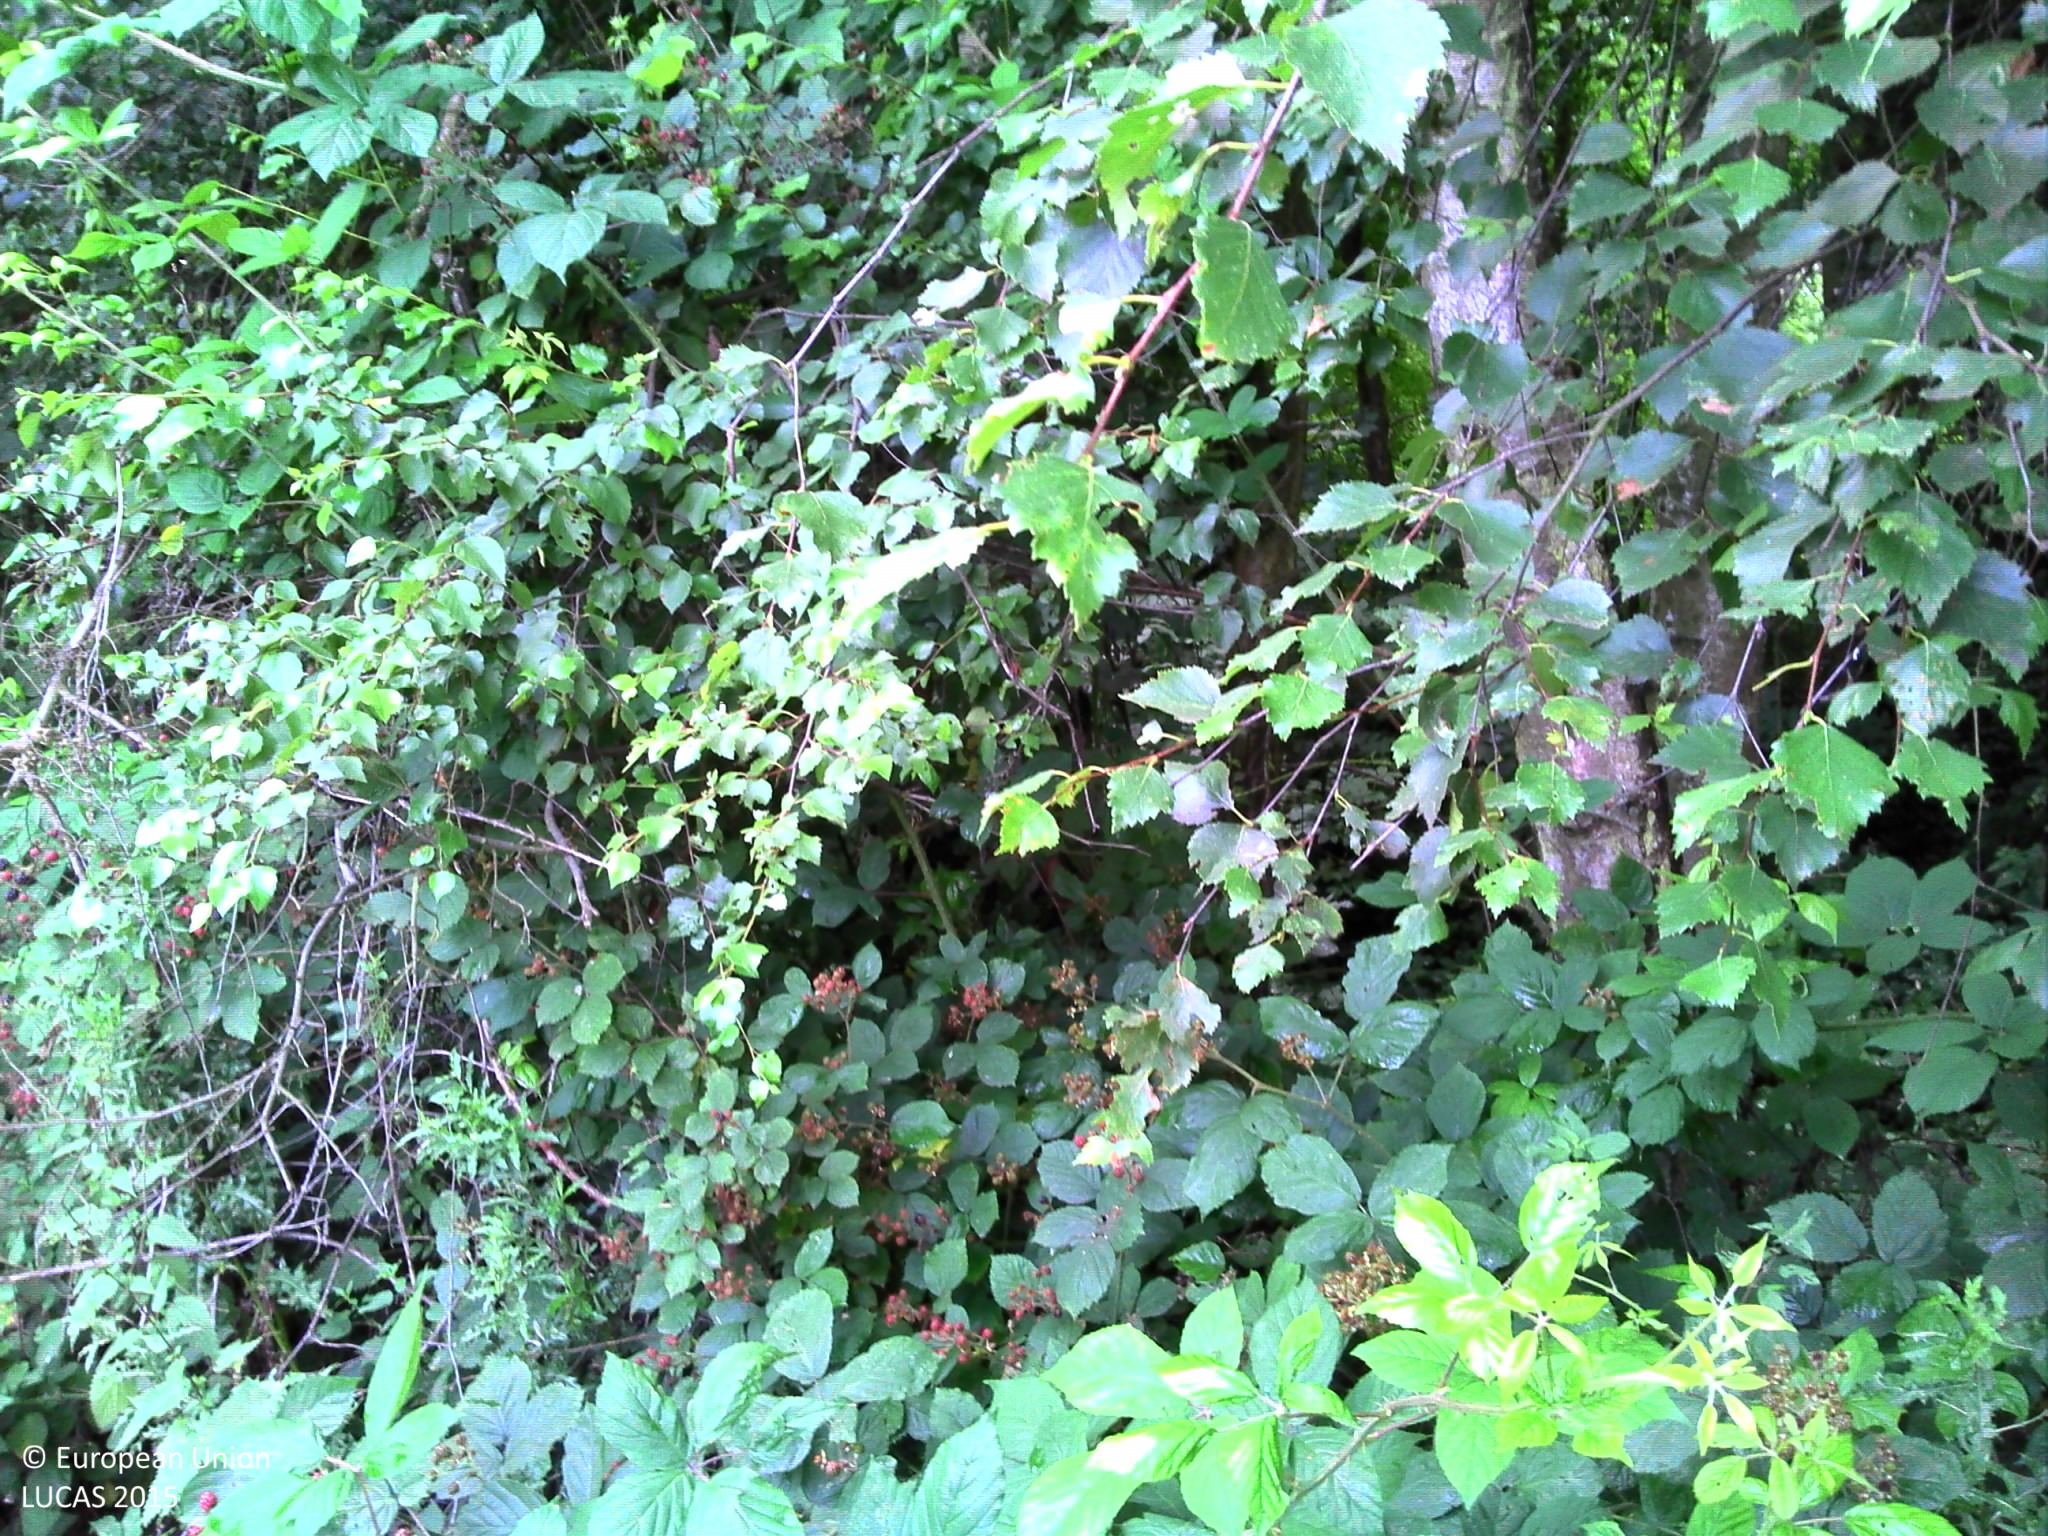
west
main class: Woodland
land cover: Spruce dominated mixed woodland
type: exotic forest
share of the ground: > 75 %
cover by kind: broadleaved forest trees 50 %, shrubs 25 %, coniferous forest trees 20 %, herbaceous plants 5 %
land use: Forestry
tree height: > 5 m
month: July
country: BE
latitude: 50.4489
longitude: 4.5176
